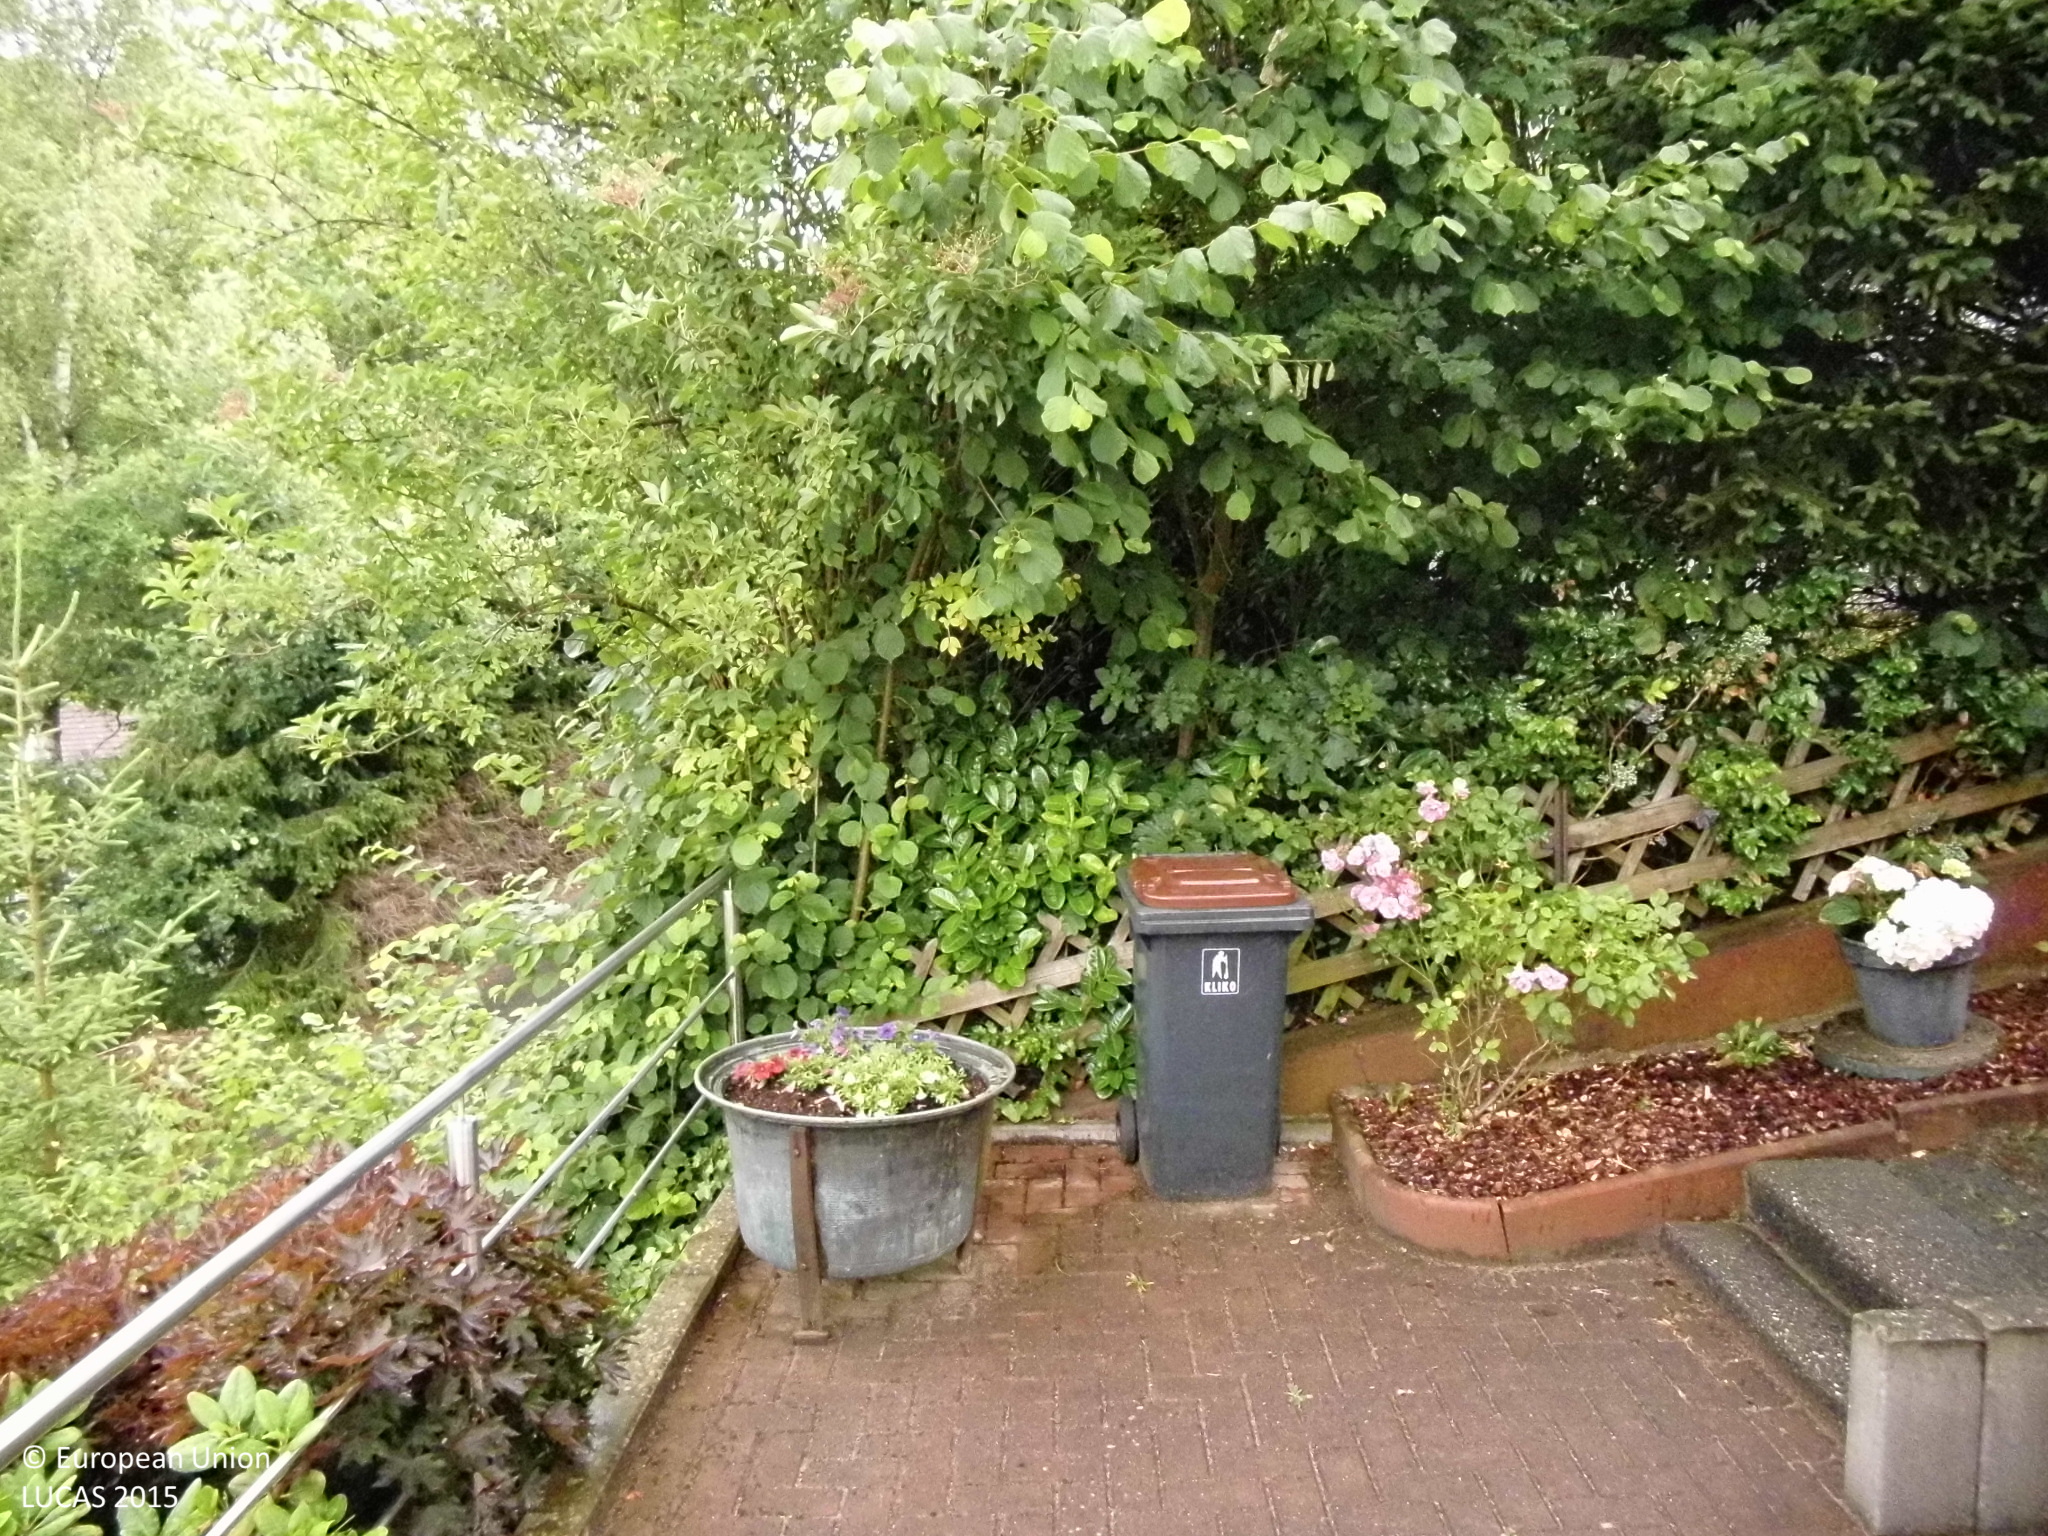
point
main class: Woodland
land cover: Broadleaved woodland
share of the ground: > 75 %
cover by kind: broadleaved forest trees 80 %, coniferous forest trees 20 %
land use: Residential
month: July
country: DE
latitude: 50.8322
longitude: 7.9984
